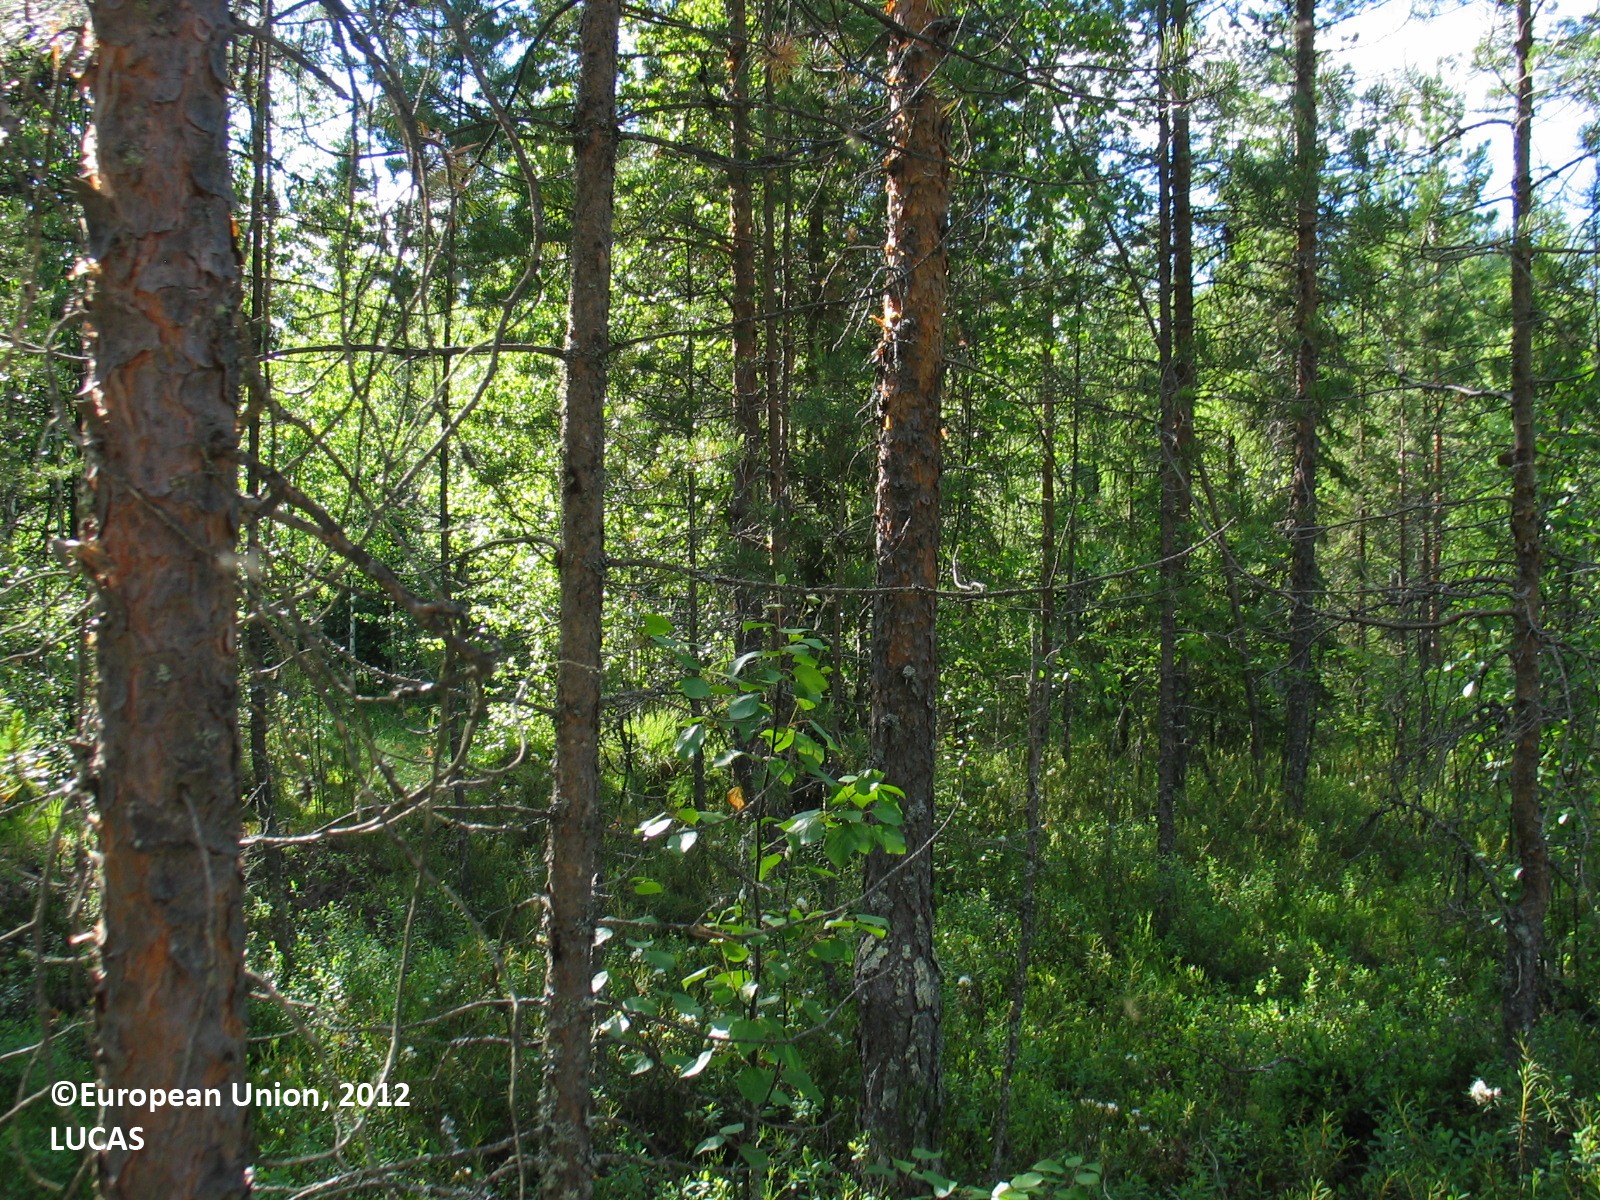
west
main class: Woodland
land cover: Pine dominated coniferous woodland
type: boreal forest
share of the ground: 50 - 75 %
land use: Forestry
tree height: > 5 m
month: July
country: FI
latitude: 64.6912
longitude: 26.7008
